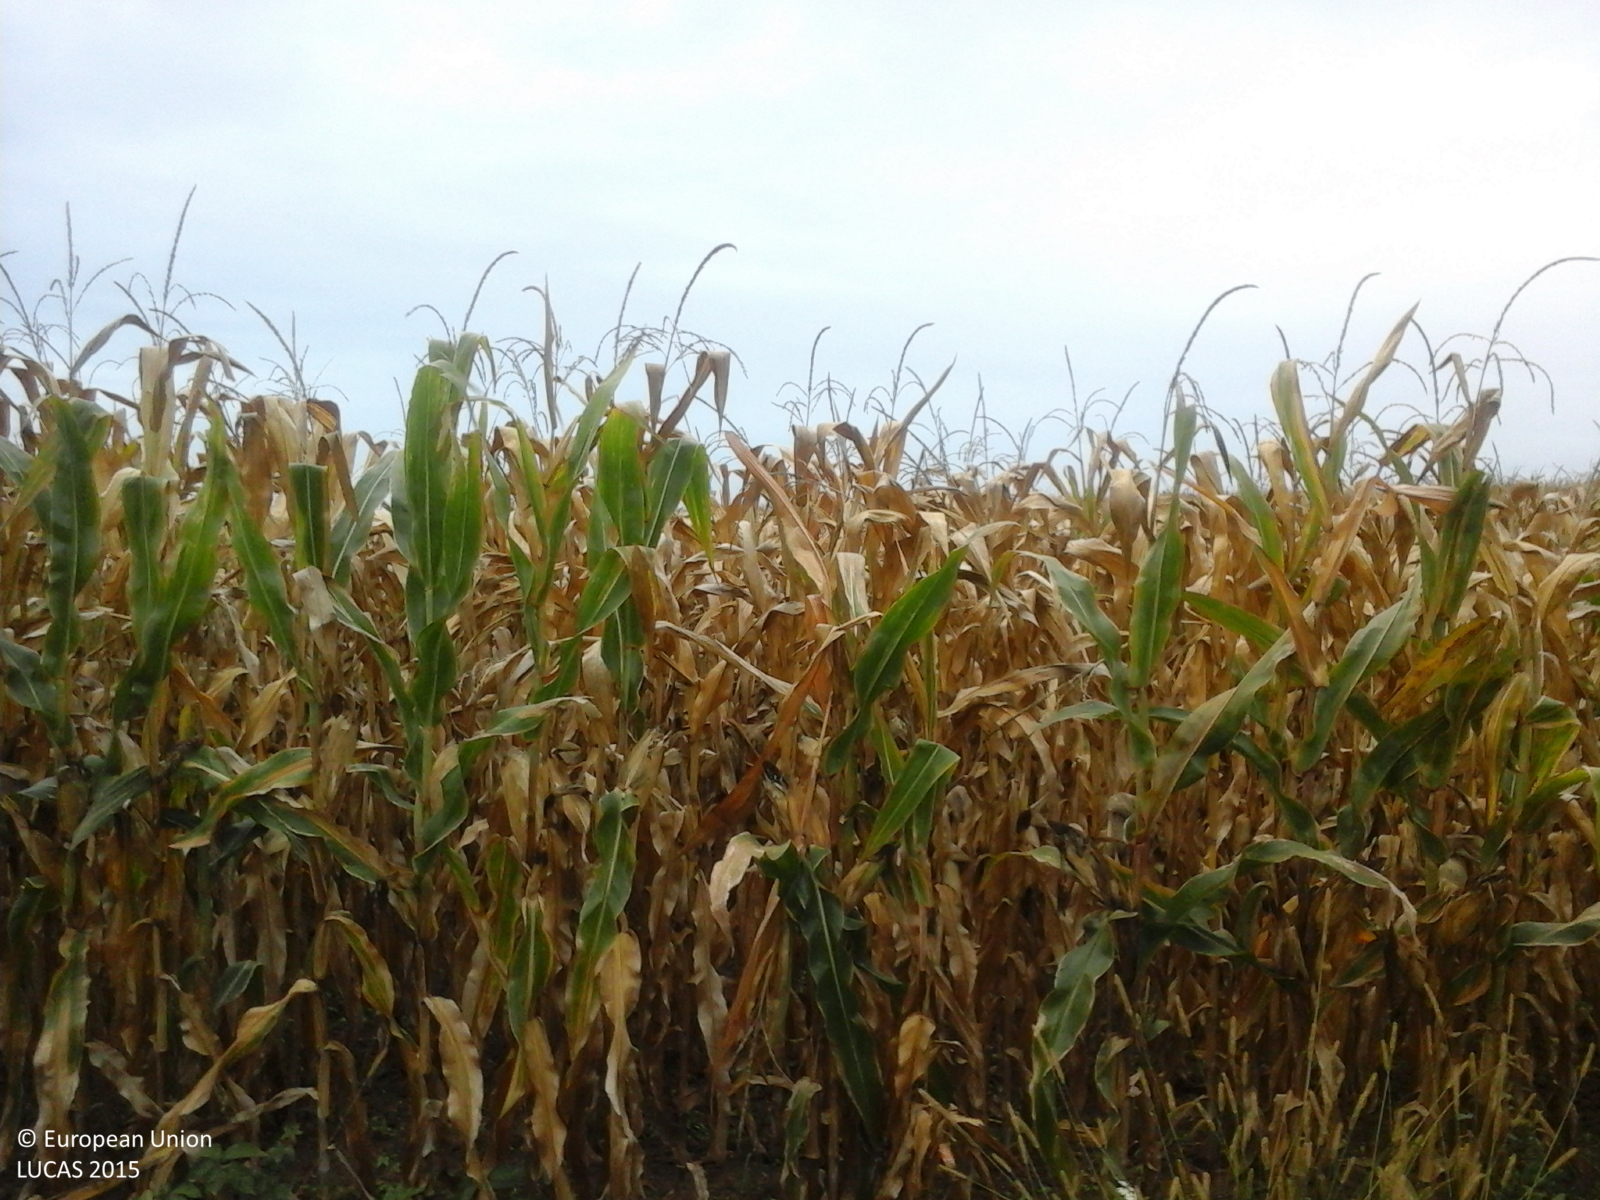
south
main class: Cropland
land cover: Maize
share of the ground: > 75 %
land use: Agriculture (excluding fallow land and kitchen gardens)
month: September
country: RO
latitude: 47.0633
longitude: 22.0962
